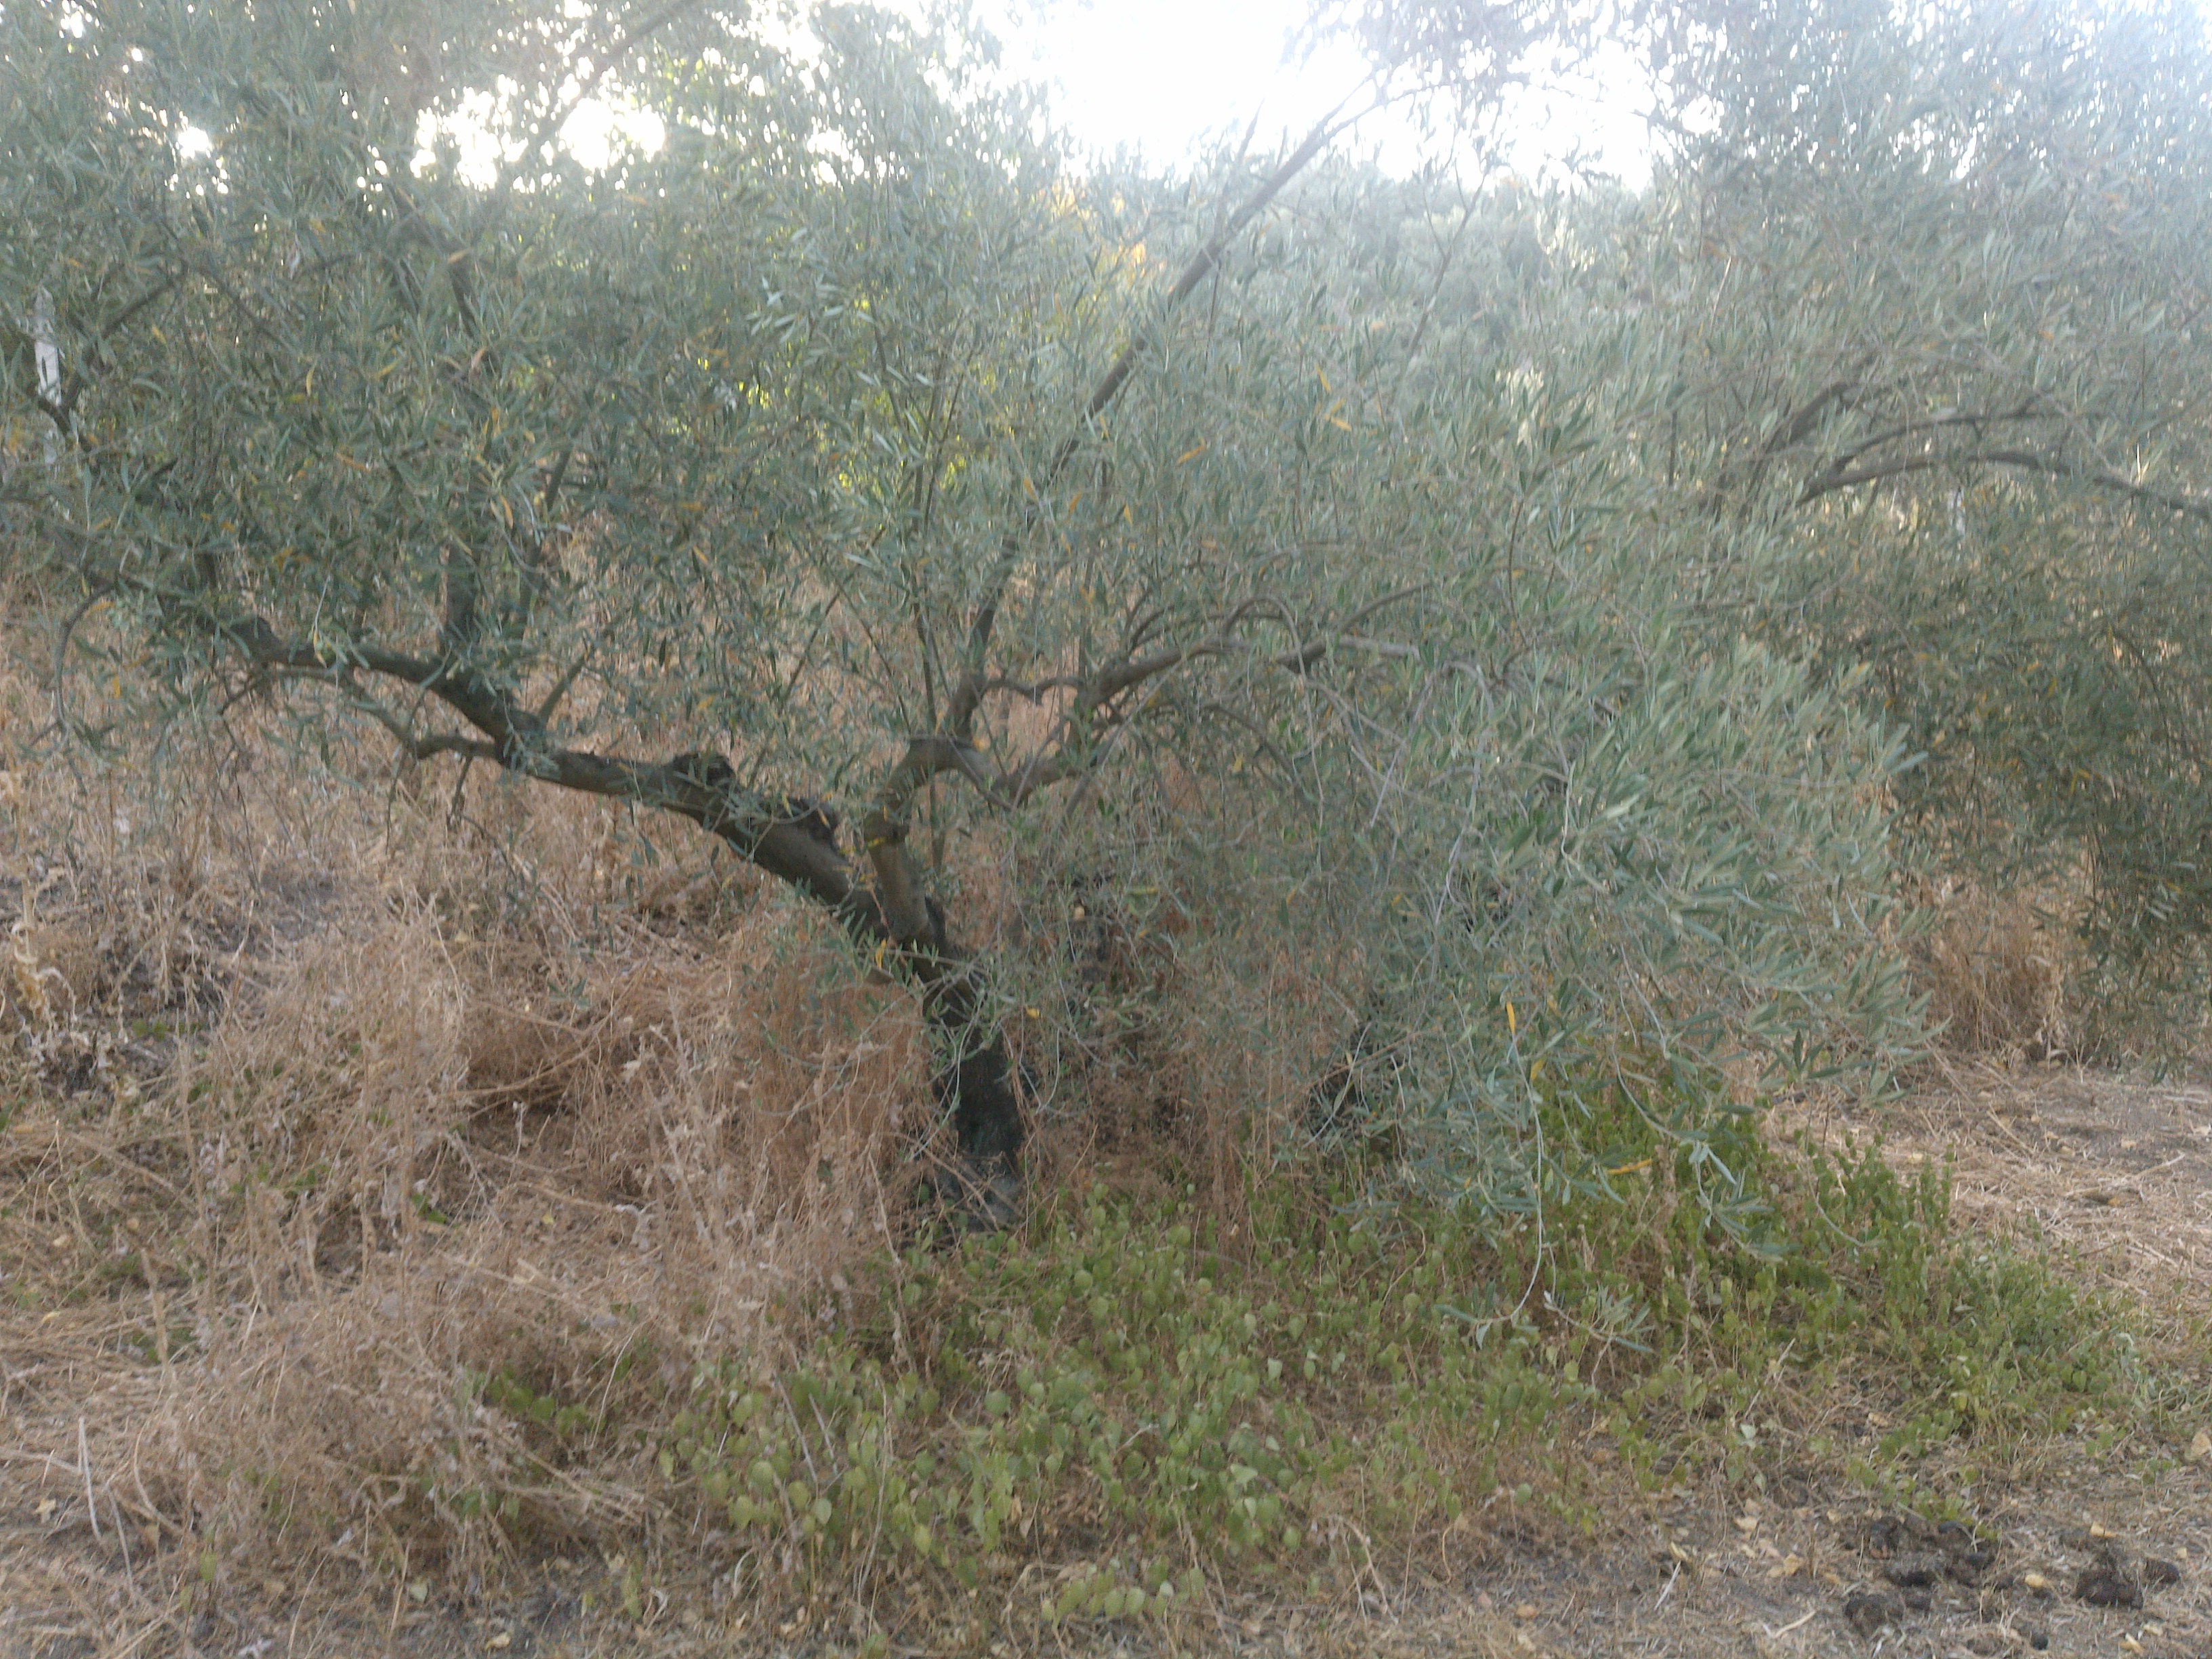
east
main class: Cropland
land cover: Olive groves
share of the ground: 50 - 75 %
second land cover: Spontaneously vegetated surfaces
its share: 10 - 25 %
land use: Agriculture (excluding fallow land and kitchen gardens)
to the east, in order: Olive groves; Spontaneously vegetated surfaces; Electric lines; Fences; Broadleaved woodland; Fences; Tracks; Grass margins; Olive groves; Electric lines; Olive groves; Broadleaved woodland
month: July
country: ES
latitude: 37.3739
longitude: -4.4447
